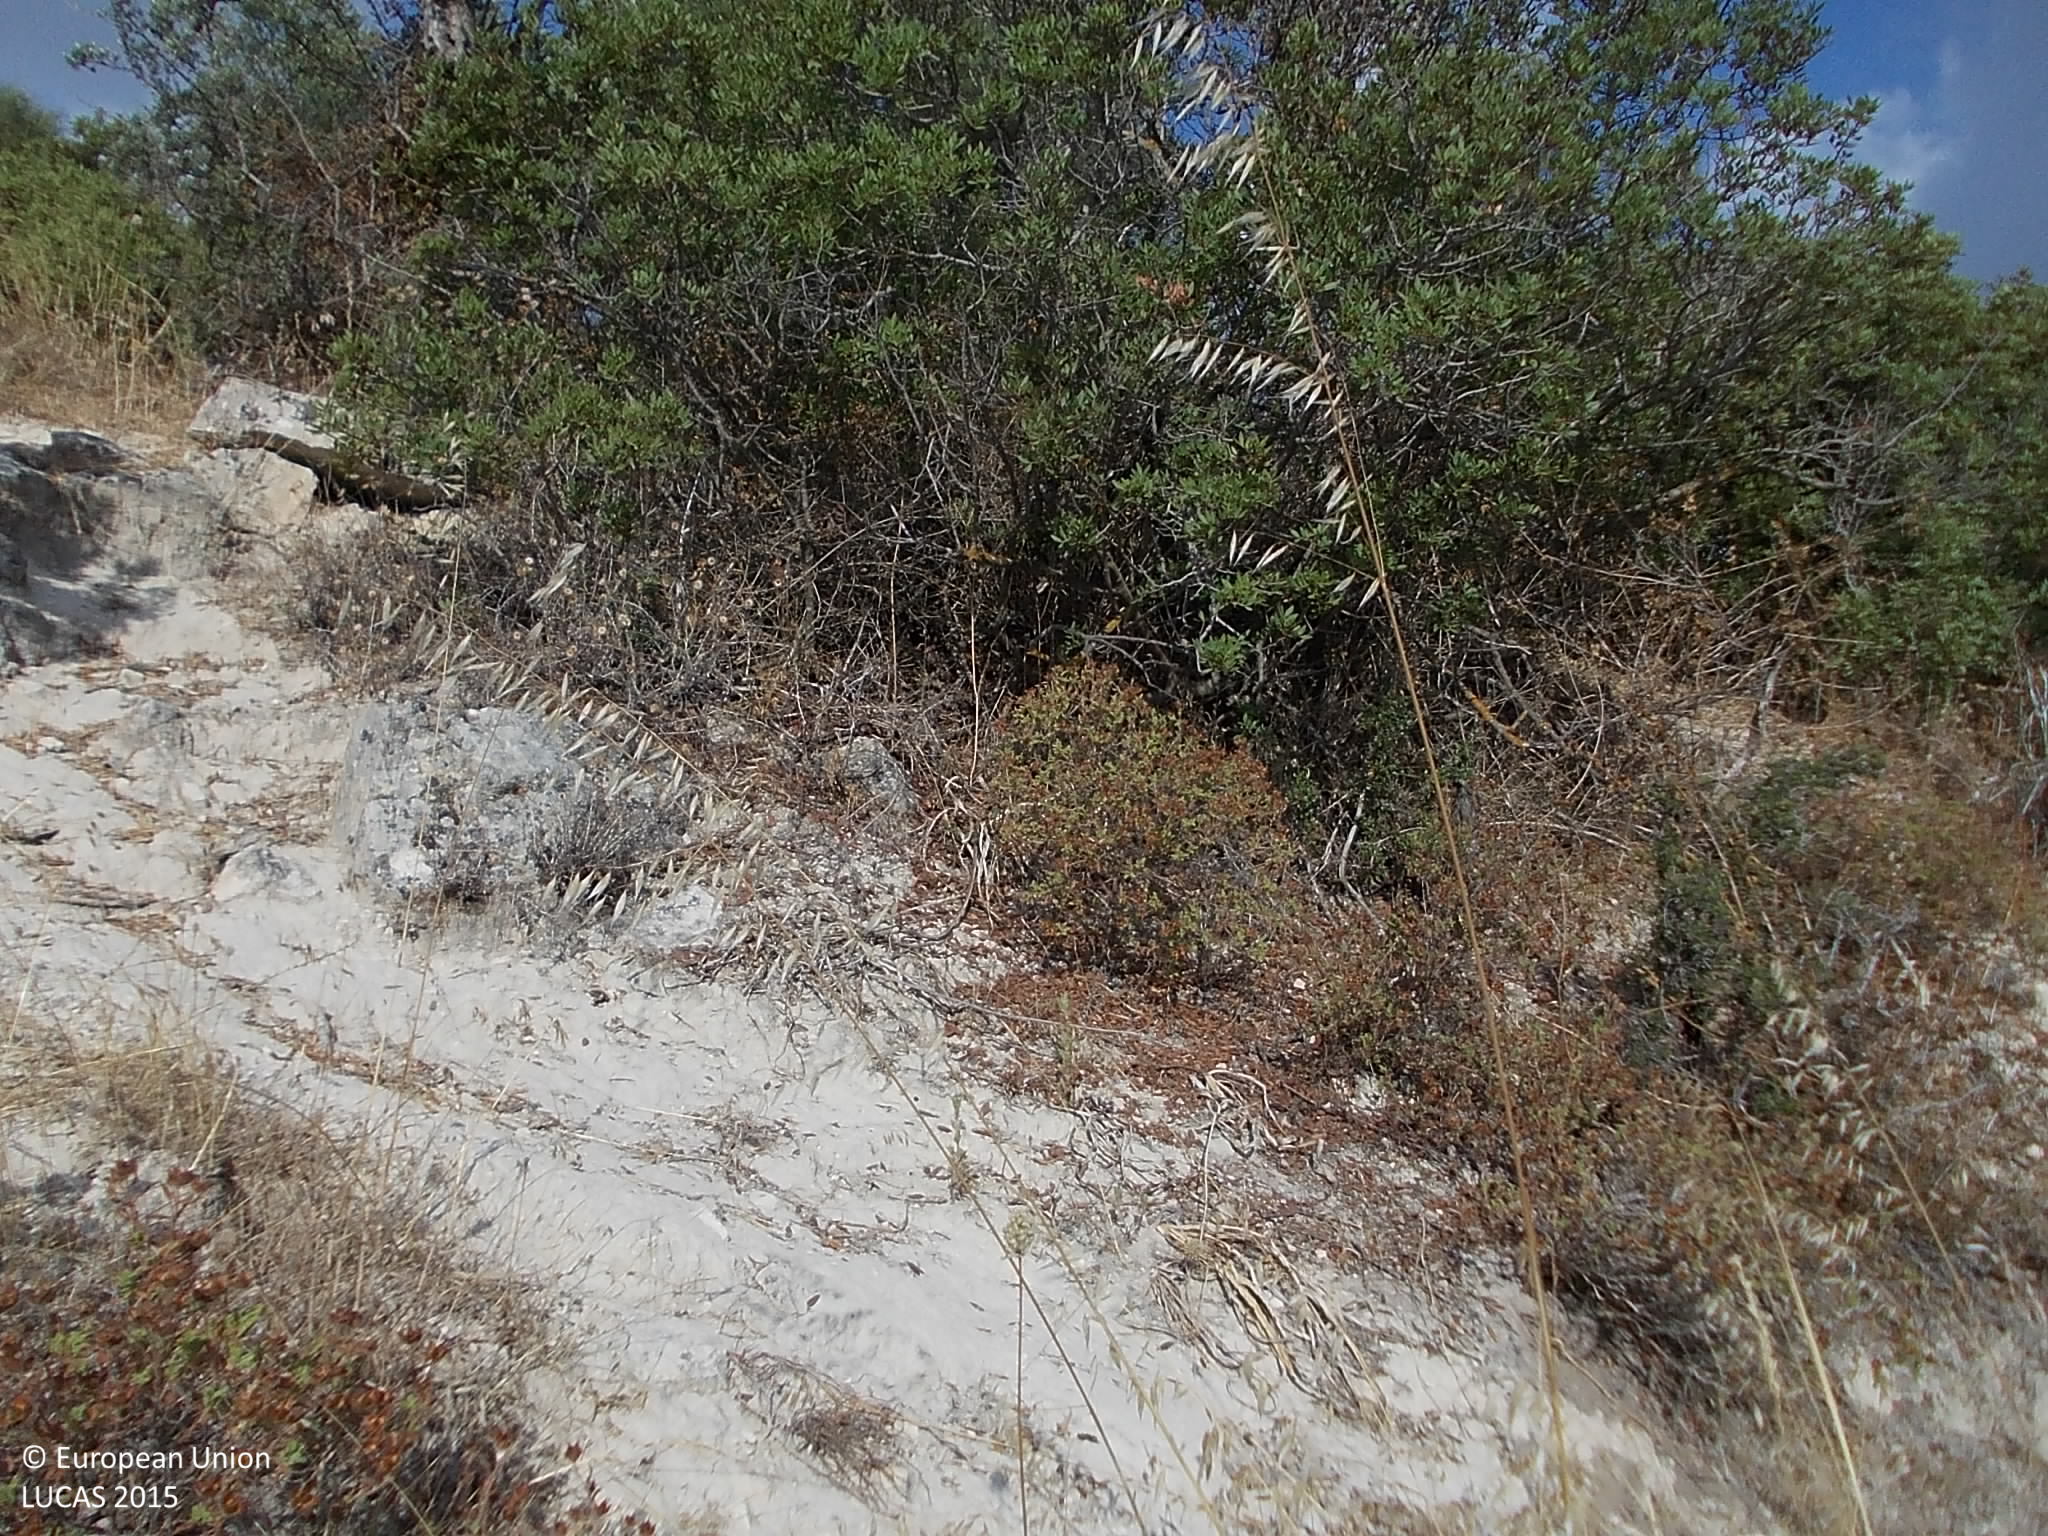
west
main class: Shrubland
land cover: Shrubland with sparse tree cover
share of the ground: > 75 %
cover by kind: shrubs 75 %, herbaceous plants 10 %, unconsolidated bare surface 10 %, broadleaved forest trees 5 %
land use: Semi-natural and natural areas not in use
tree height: < 5 m
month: August
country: CY
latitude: 34.6970
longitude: 32.7177
